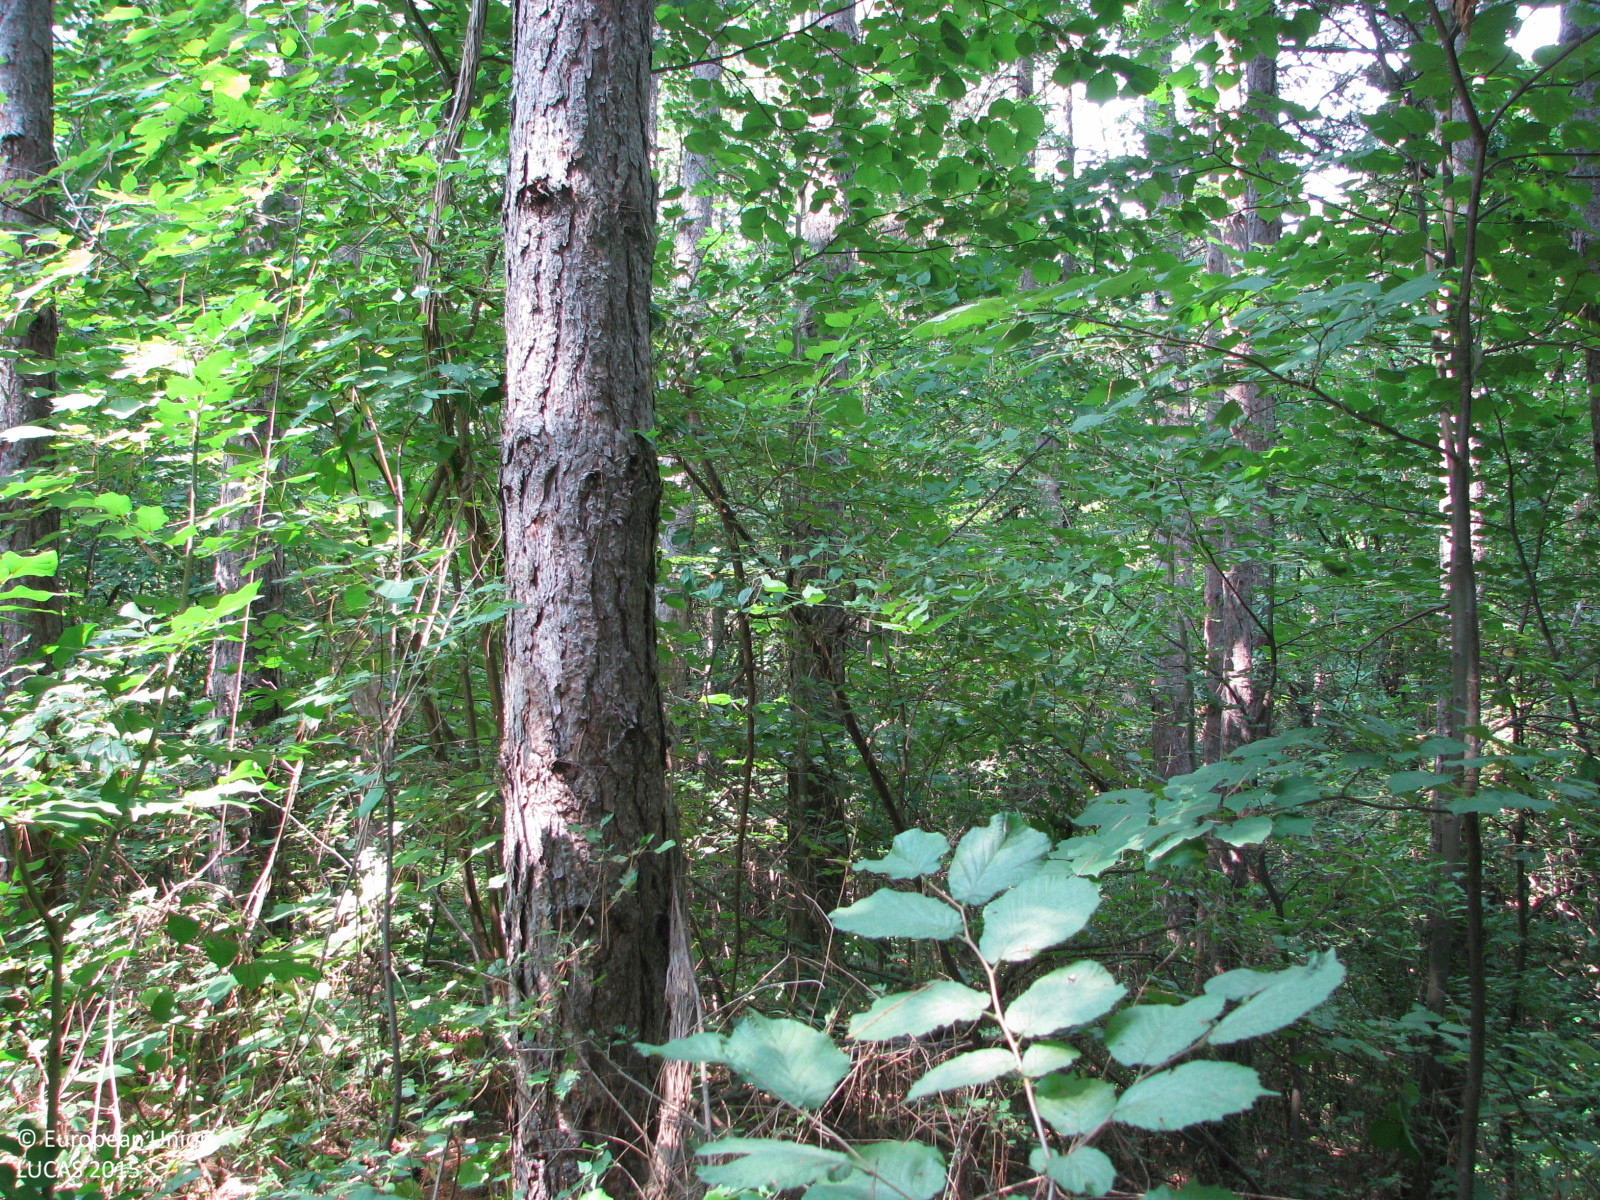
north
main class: Woodland
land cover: Pine dominated mixed woodland
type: hemiboreal forest and nemoral coniferous forest and mixed broadleaved-coniferous forest
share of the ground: 50 - 75 %
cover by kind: coniferous forest trees 50 %, broadleaved forest trees 20 %, shrubs 15 %, unconsolidated bare surface 15 %
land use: Forestry
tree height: > 5 m
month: August
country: BG
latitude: 42.5839
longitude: 26.0076
